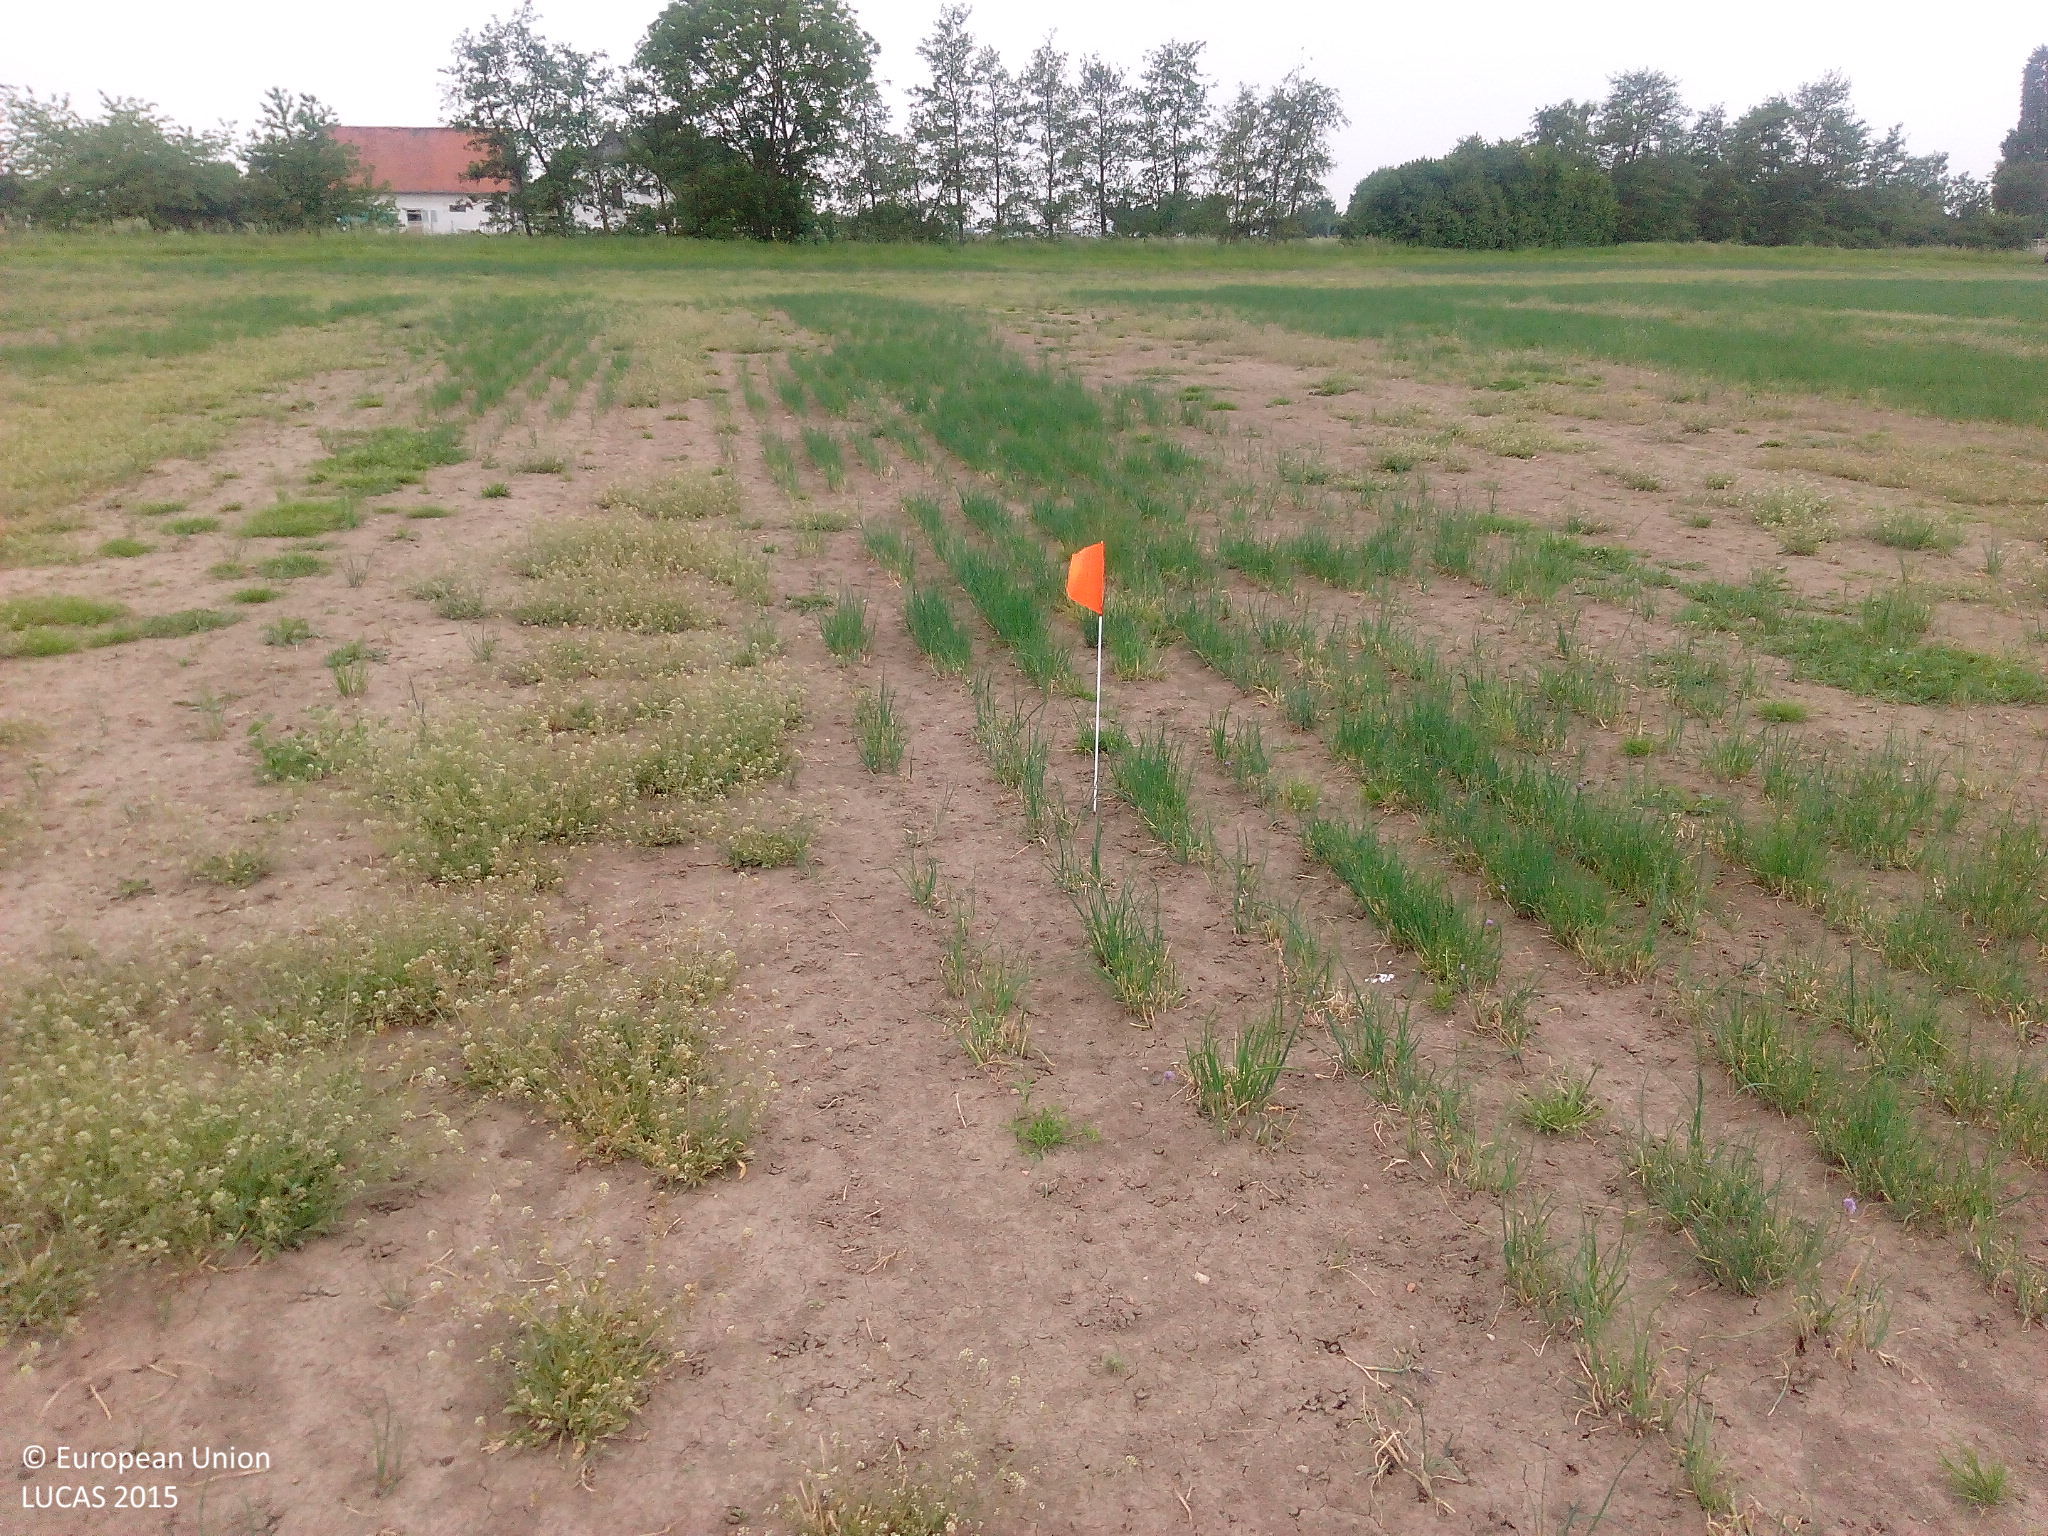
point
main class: Cropland
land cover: Other fresh vegetables
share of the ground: 10 - 25 %
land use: Agriculture (excluding fallow land and kitchen gardens)
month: May
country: DE
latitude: 49.7789
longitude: 8.5145
